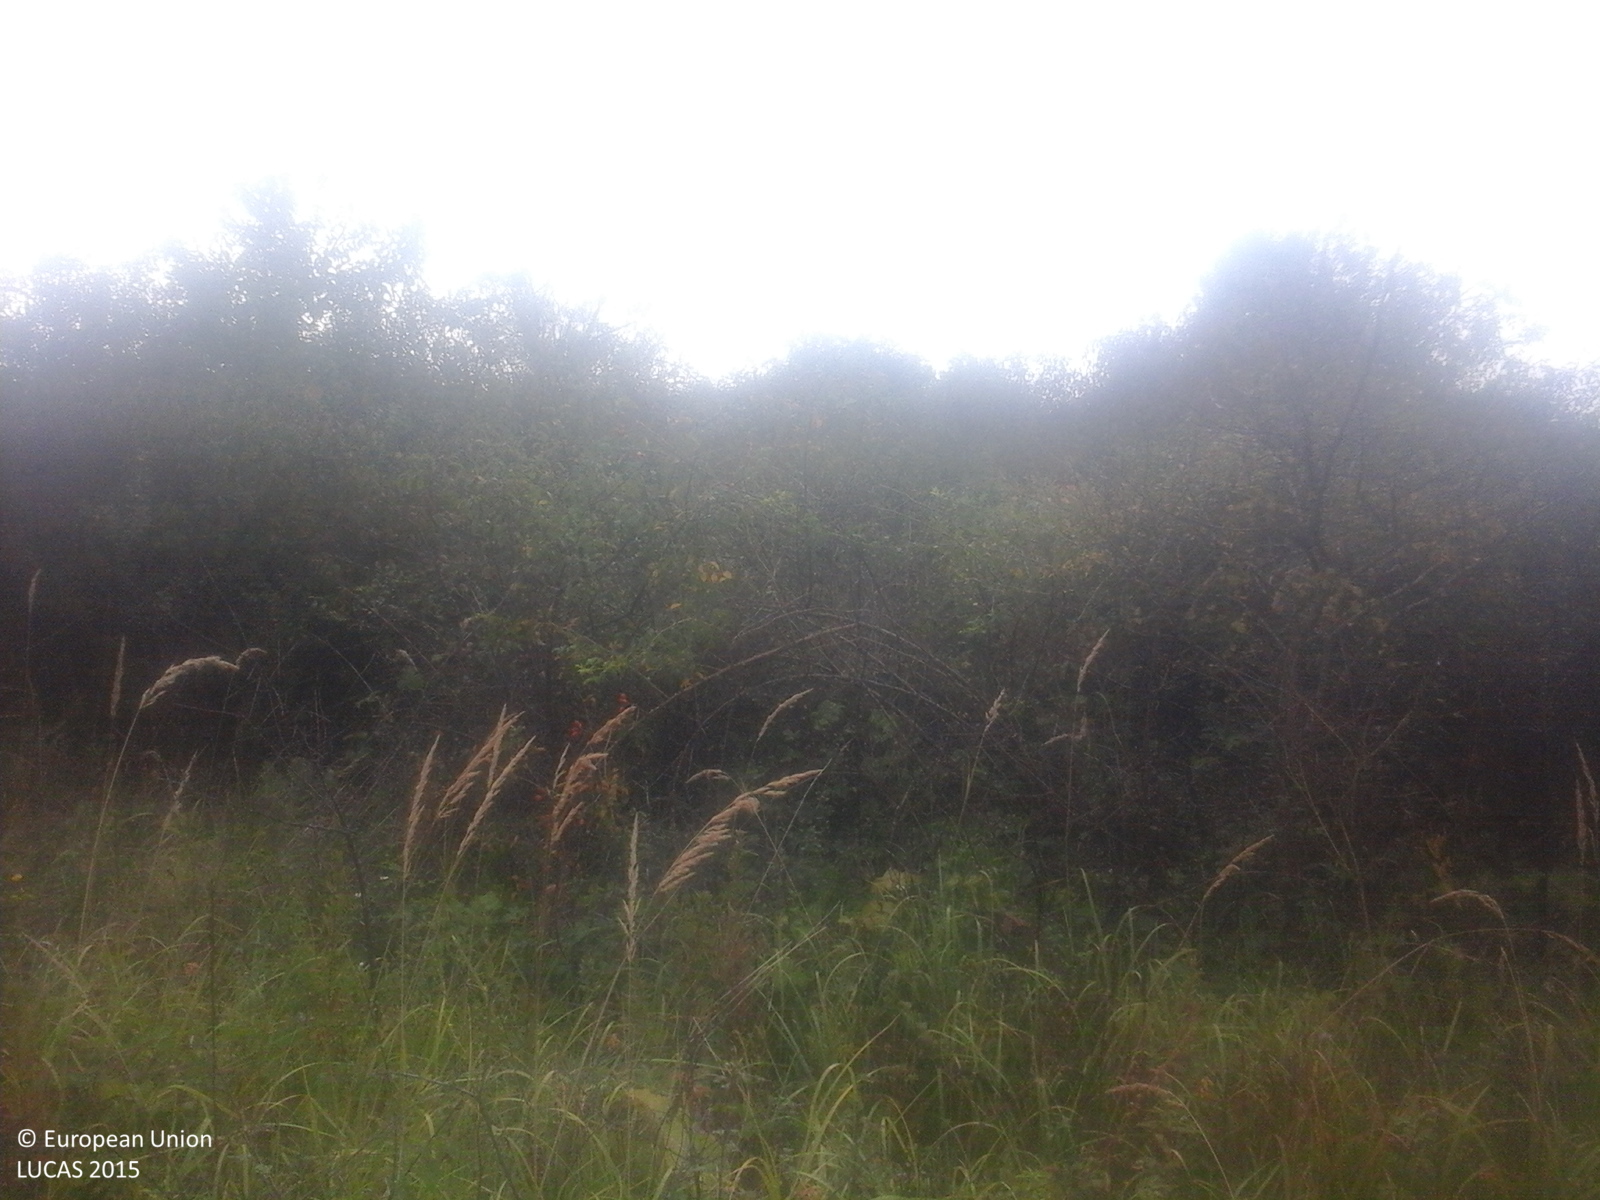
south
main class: Shrubland
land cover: Shrubland without tree cover
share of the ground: > 75 %
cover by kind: shrubs 60 %, herbaceous plants 40 %
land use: Fallow land
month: September
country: RO
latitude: 45.4815
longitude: 21.9225
